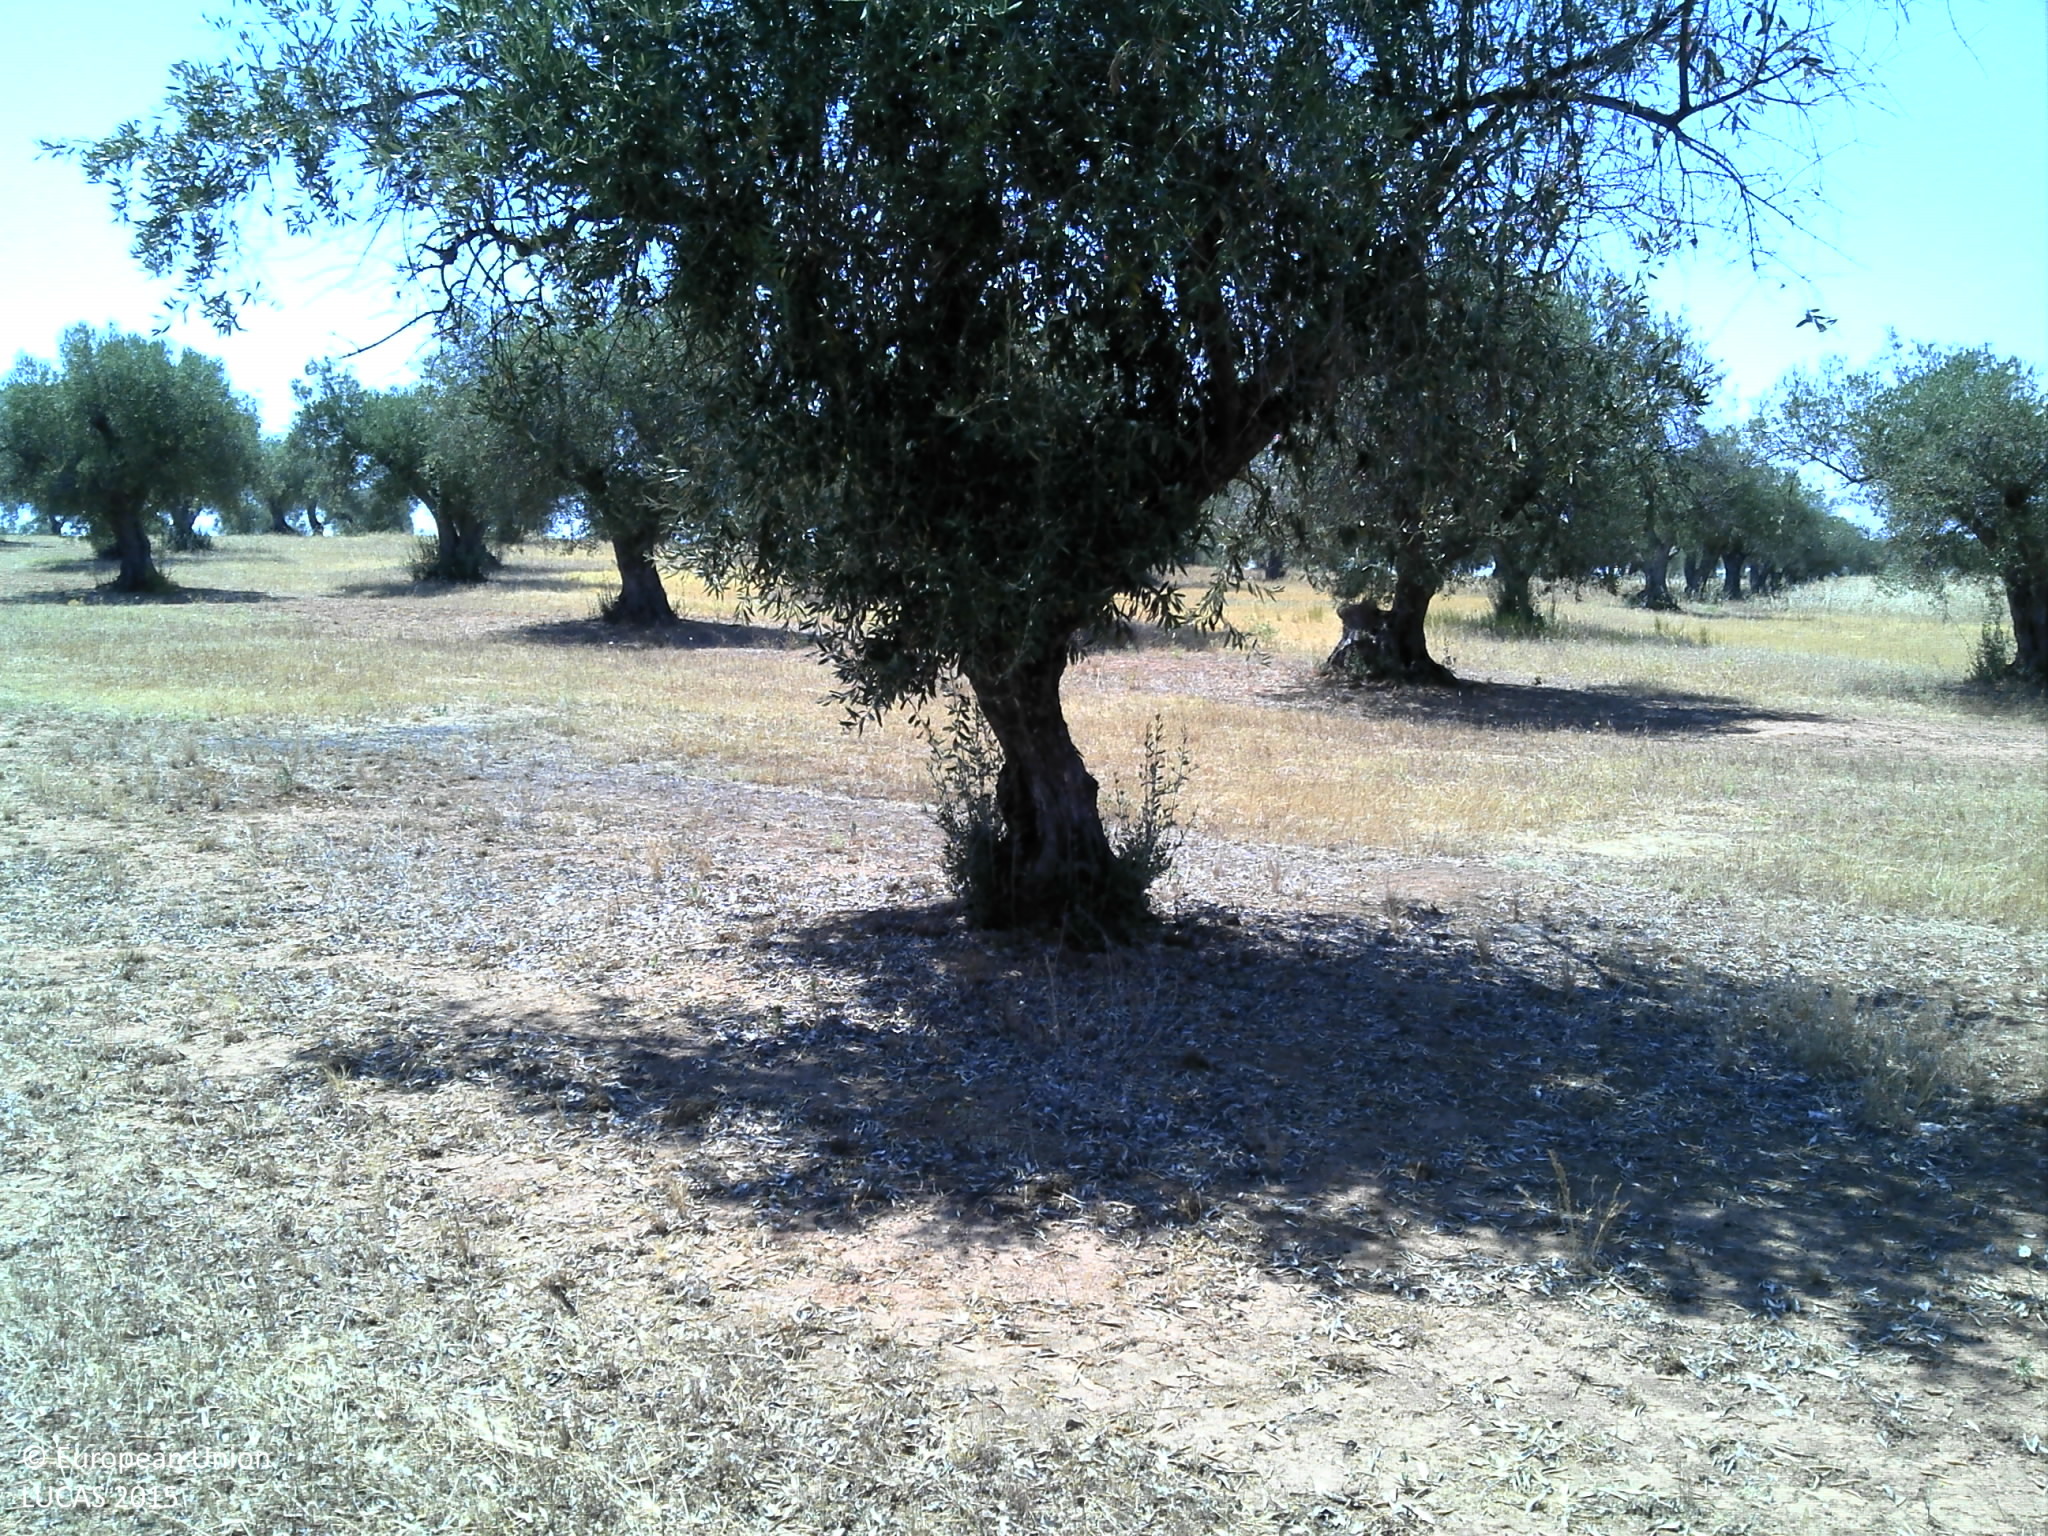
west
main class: Cropland
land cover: Olive groves
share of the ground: 25 - 50 %
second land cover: Grassland without tree/shrub cover
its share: 10 - 25 %
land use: Agriculture (excluding fallow land and kitchen gardens)
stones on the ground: < 10 %
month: June
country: PT
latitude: 38.0419
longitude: -7.5573
